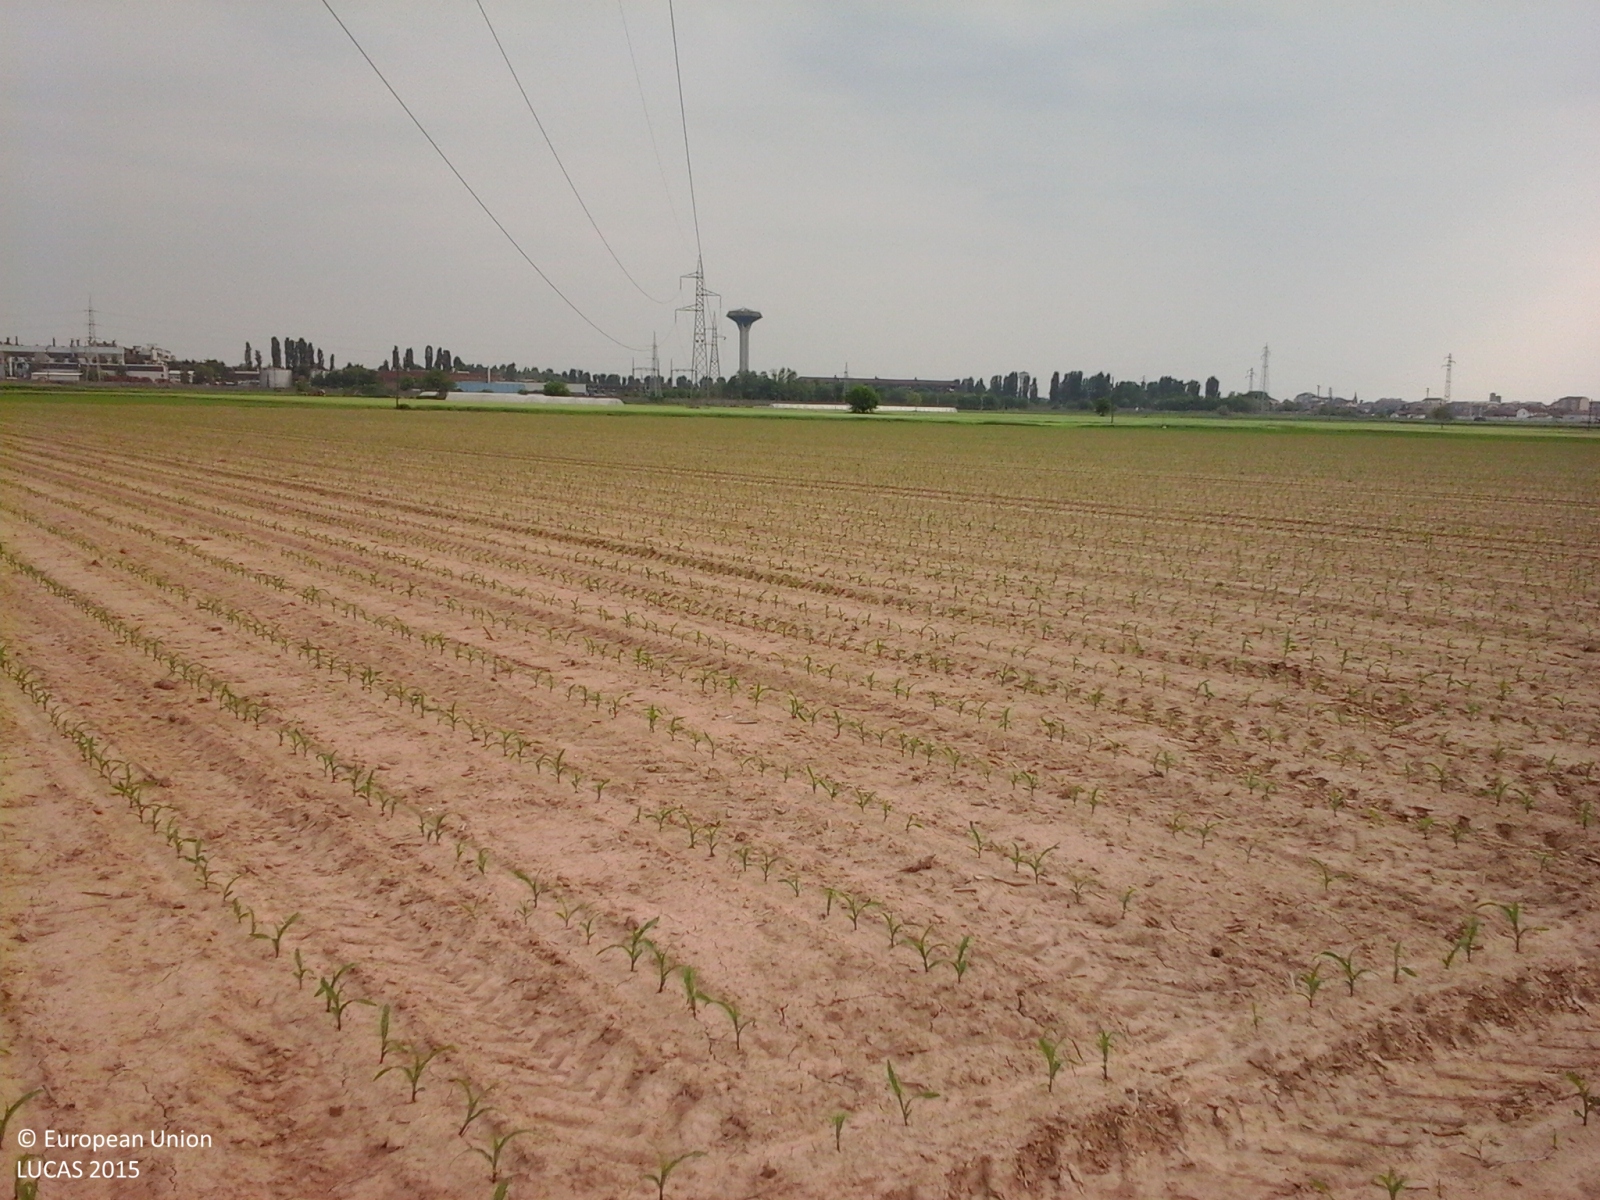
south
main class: Cropland
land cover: Maize
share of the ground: < 10 %
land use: Agriculture (excluding fallow land and kitchen gardens)
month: May
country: IT
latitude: 44.8671
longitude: 7.7387
